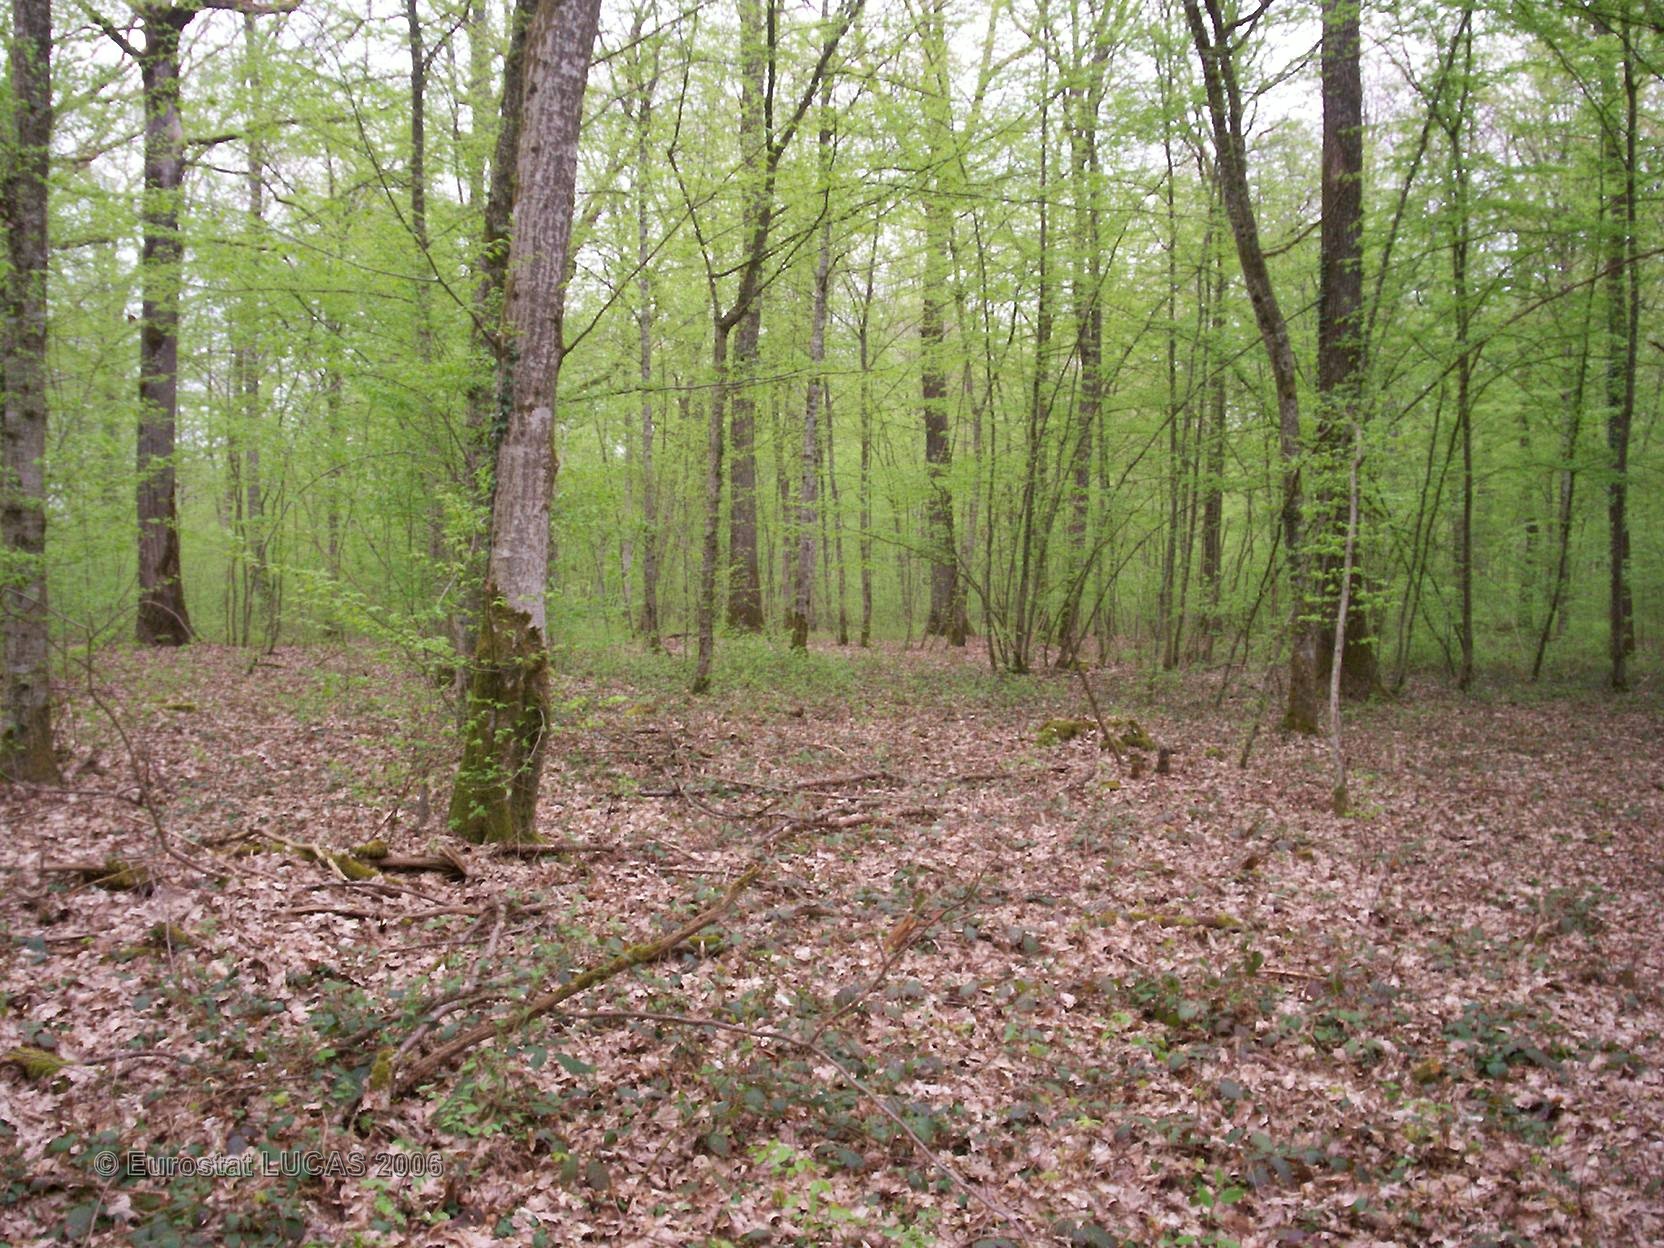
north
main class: Woodland
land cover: Broadleaved forest
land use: Forestry
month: April
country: FR
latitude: 48.3309
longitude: 5.9940
